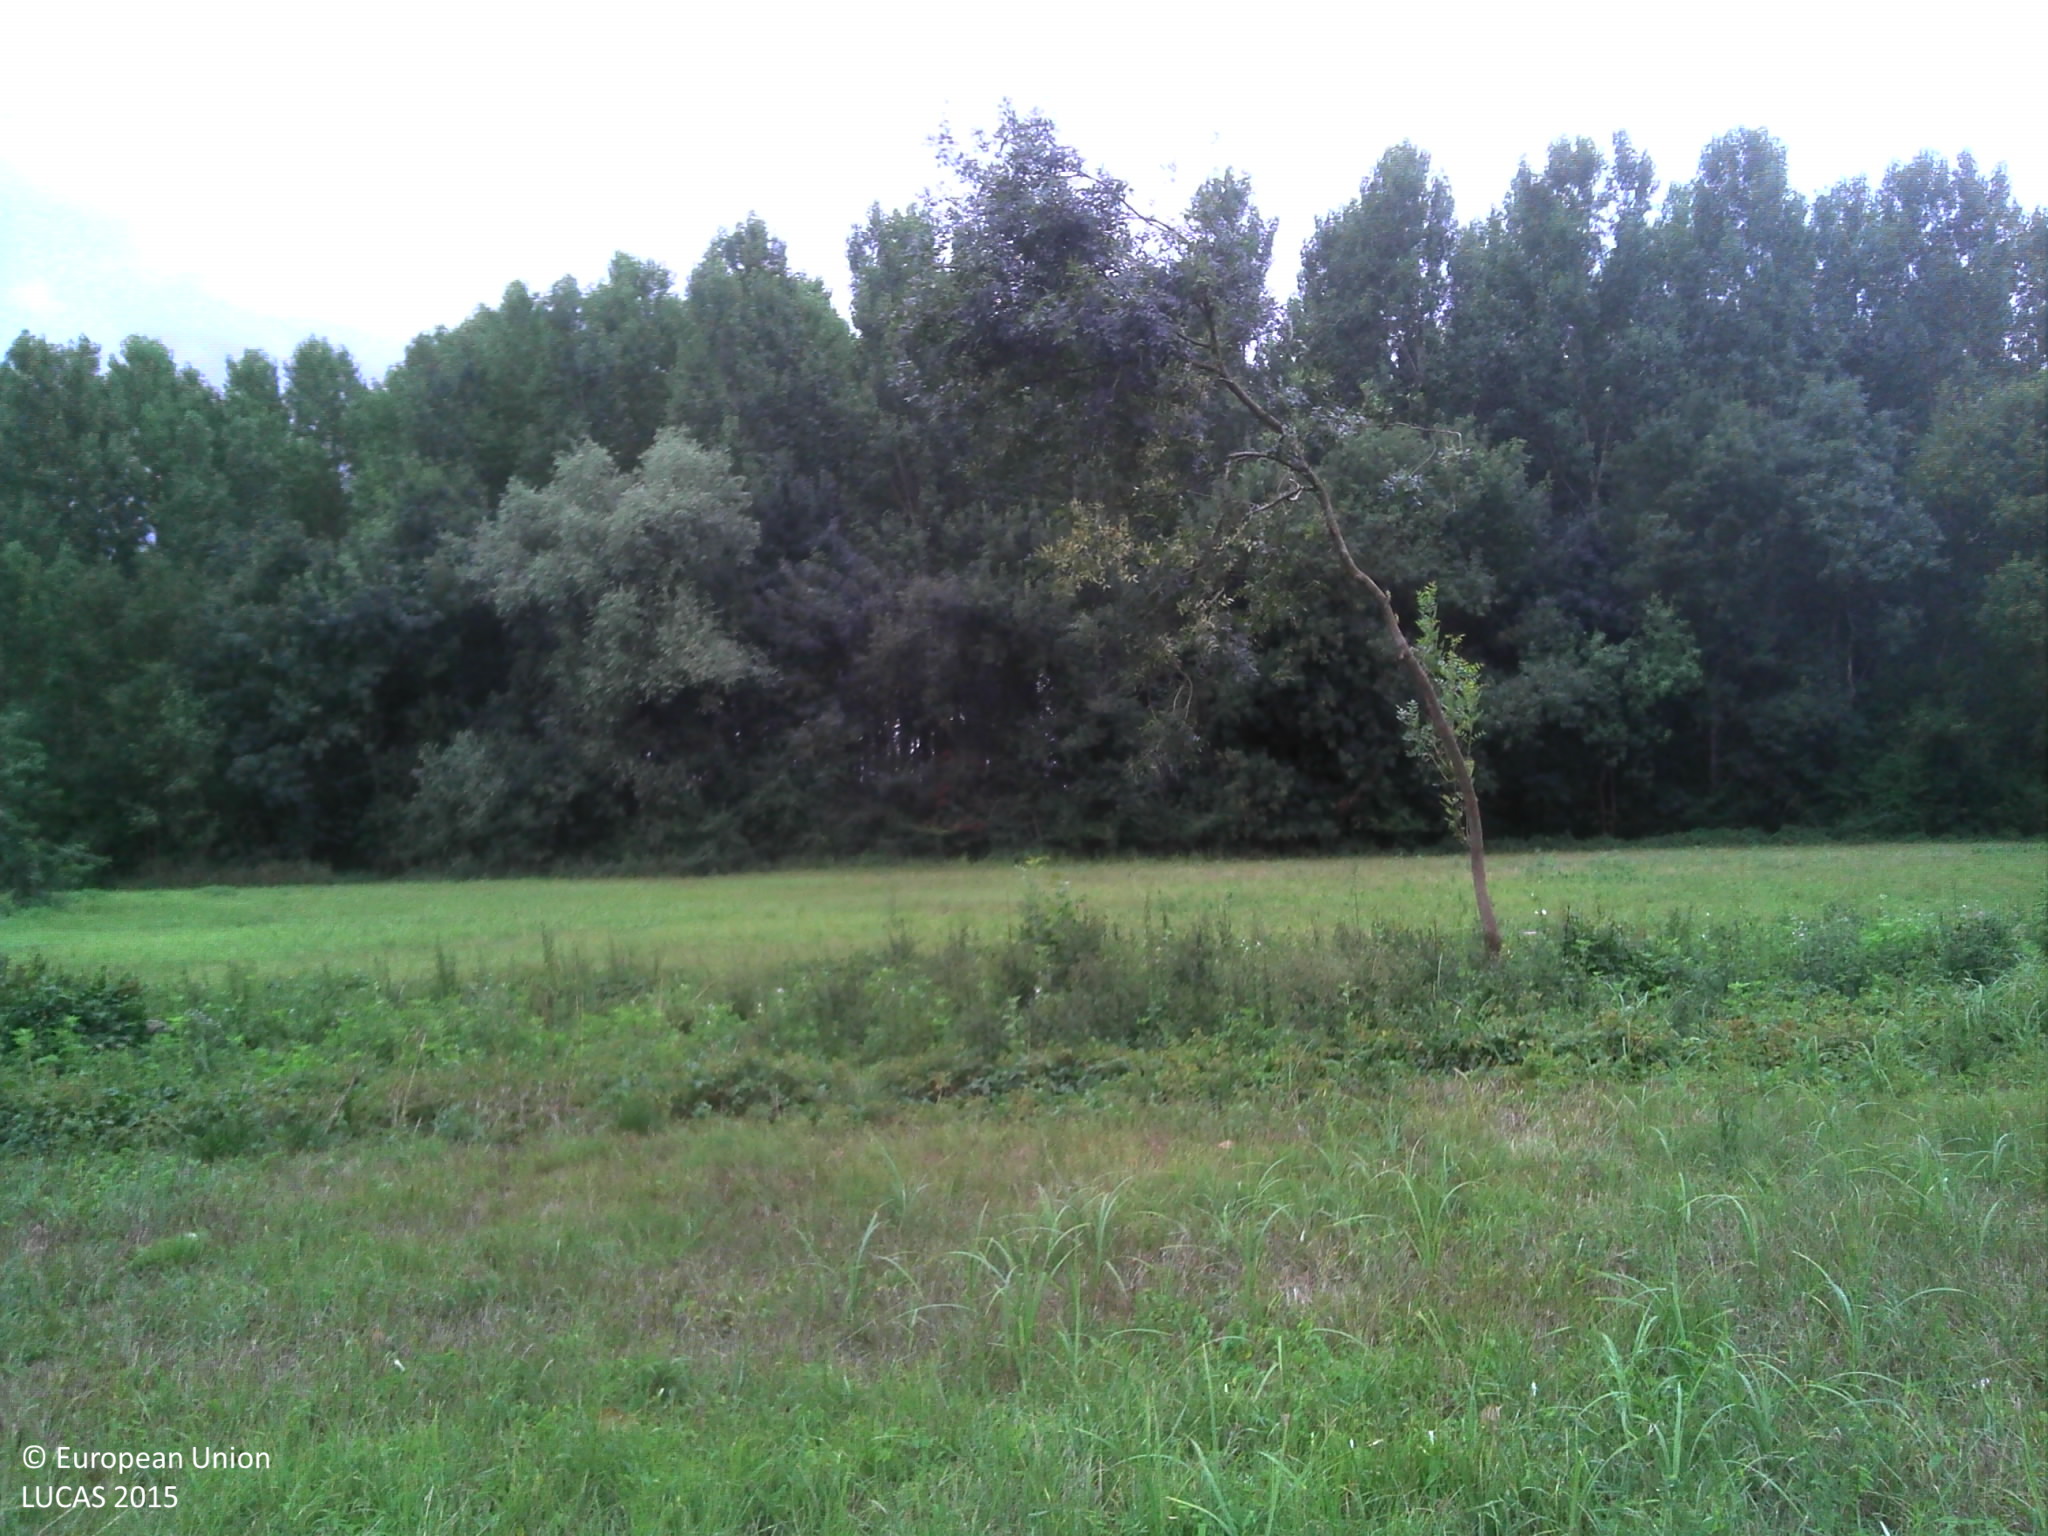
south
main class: Grassland
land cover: Grassland without tree/shrub cover
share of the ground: > 75 %
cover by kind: herbaceous plants 100 %
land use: Agriculture (excluding fallow land and kitchen gardens)
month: July
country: FR
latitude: 46.6839
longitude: 4.9680
